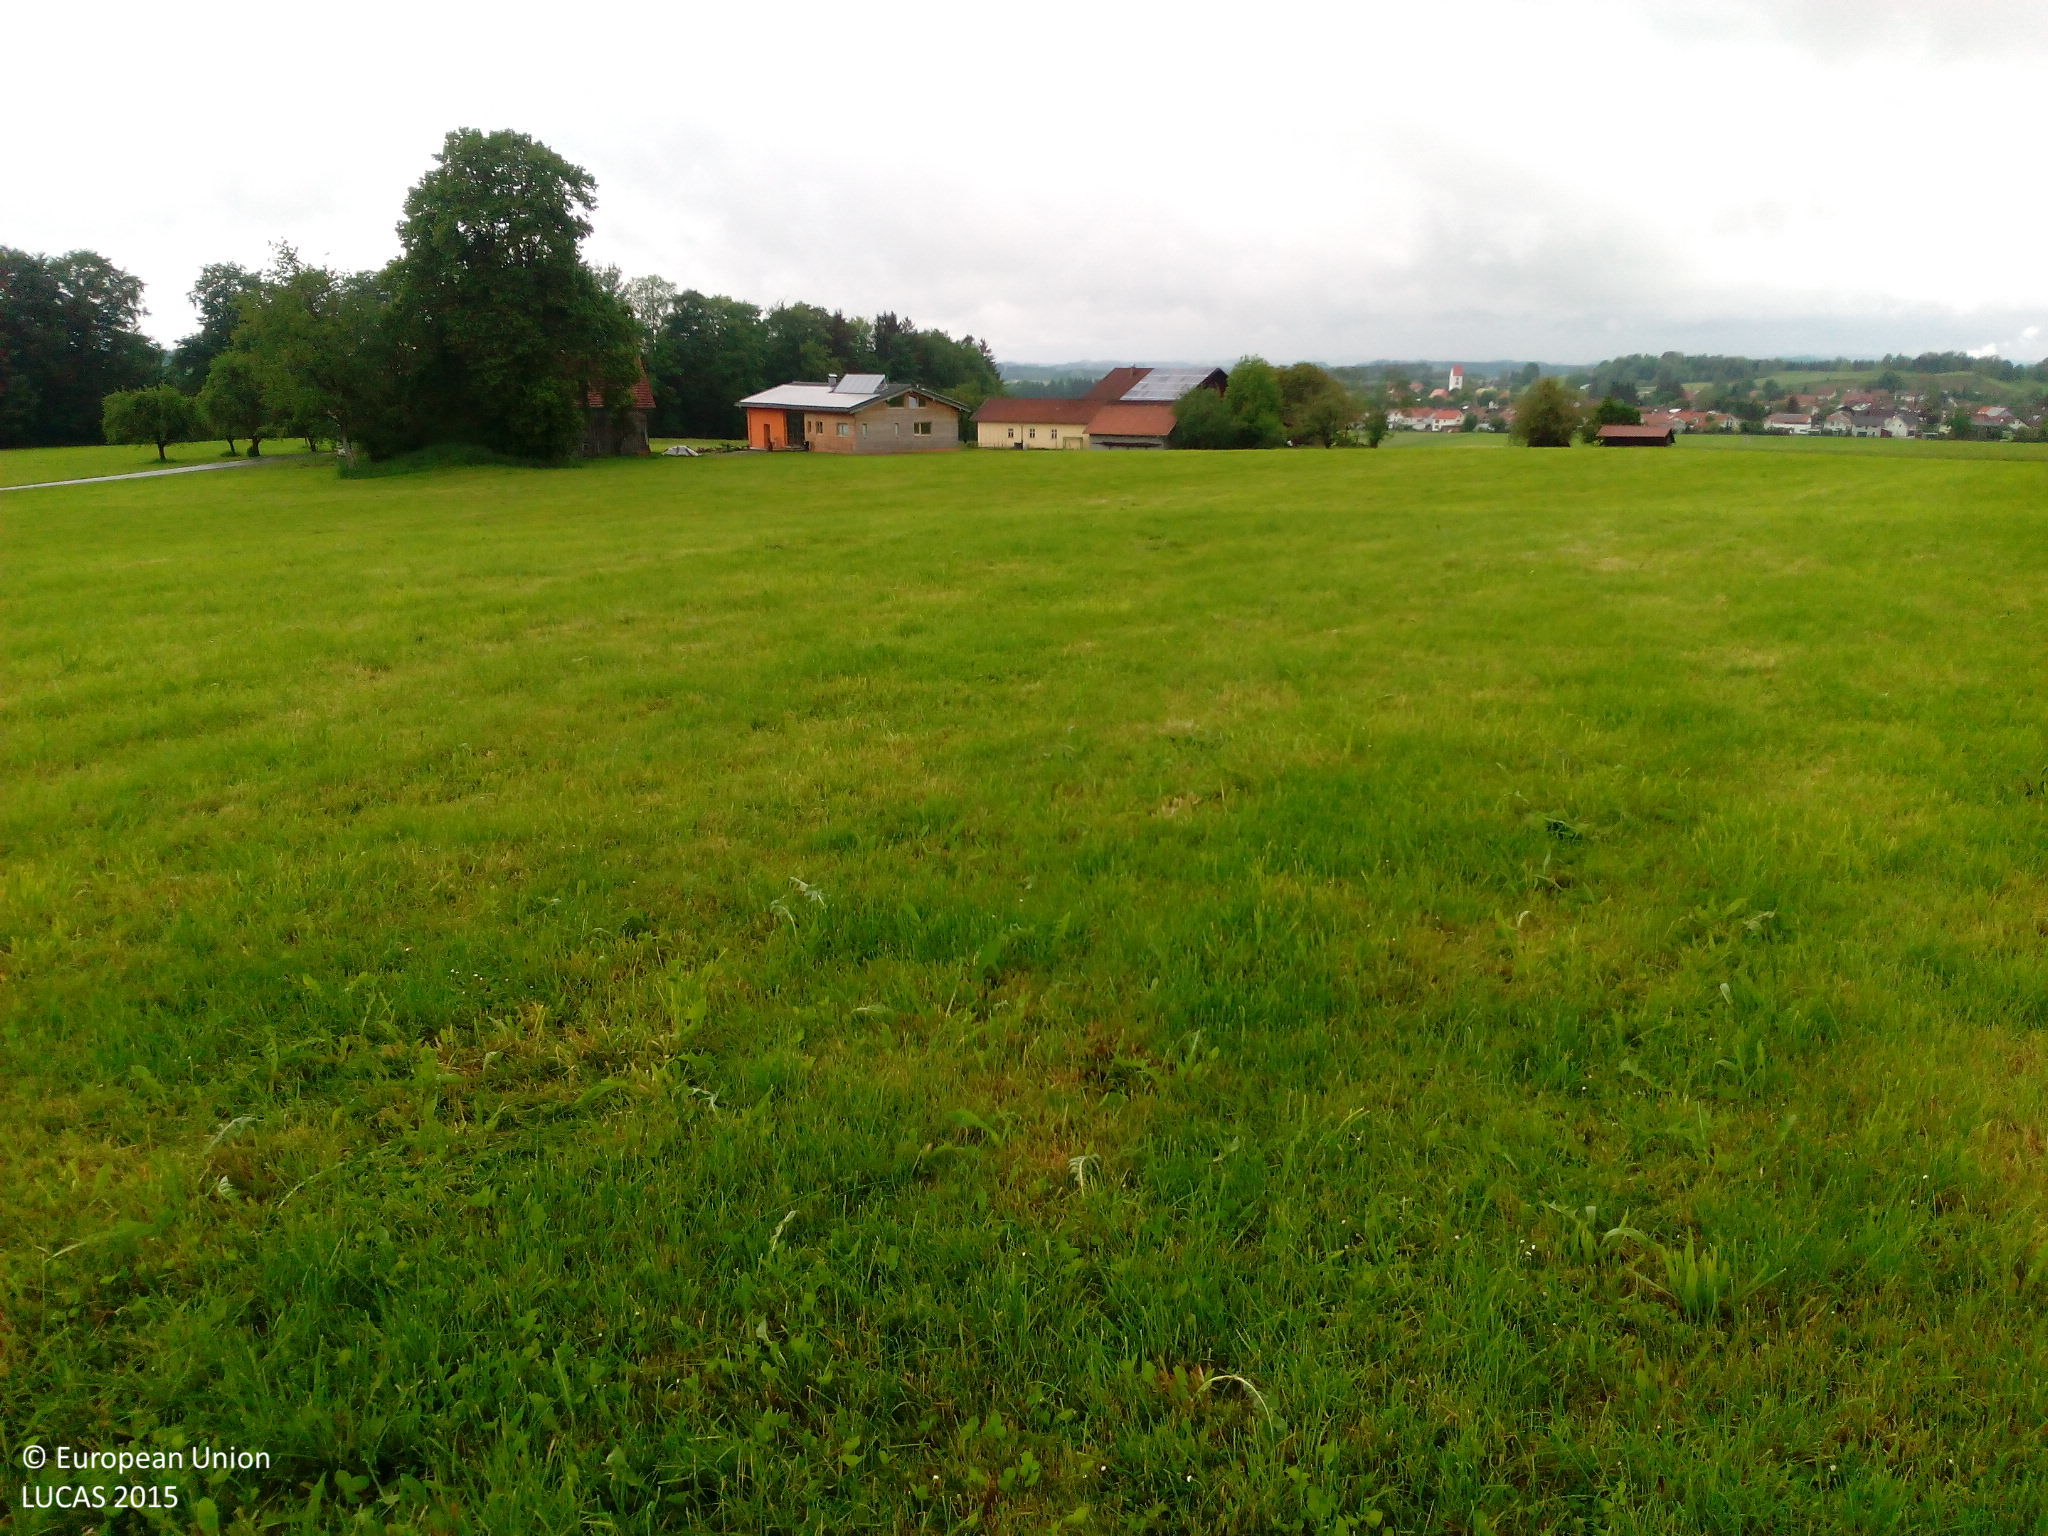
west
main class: Grassland
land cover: Grassland without tree/shrub cover
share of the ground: > 75 %
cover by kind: herbaceous plants 100 %
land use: Agriculture (excluding fallow land and kitchen gardens)
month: May
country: DE
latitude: 47.7556
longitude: 9.9334
